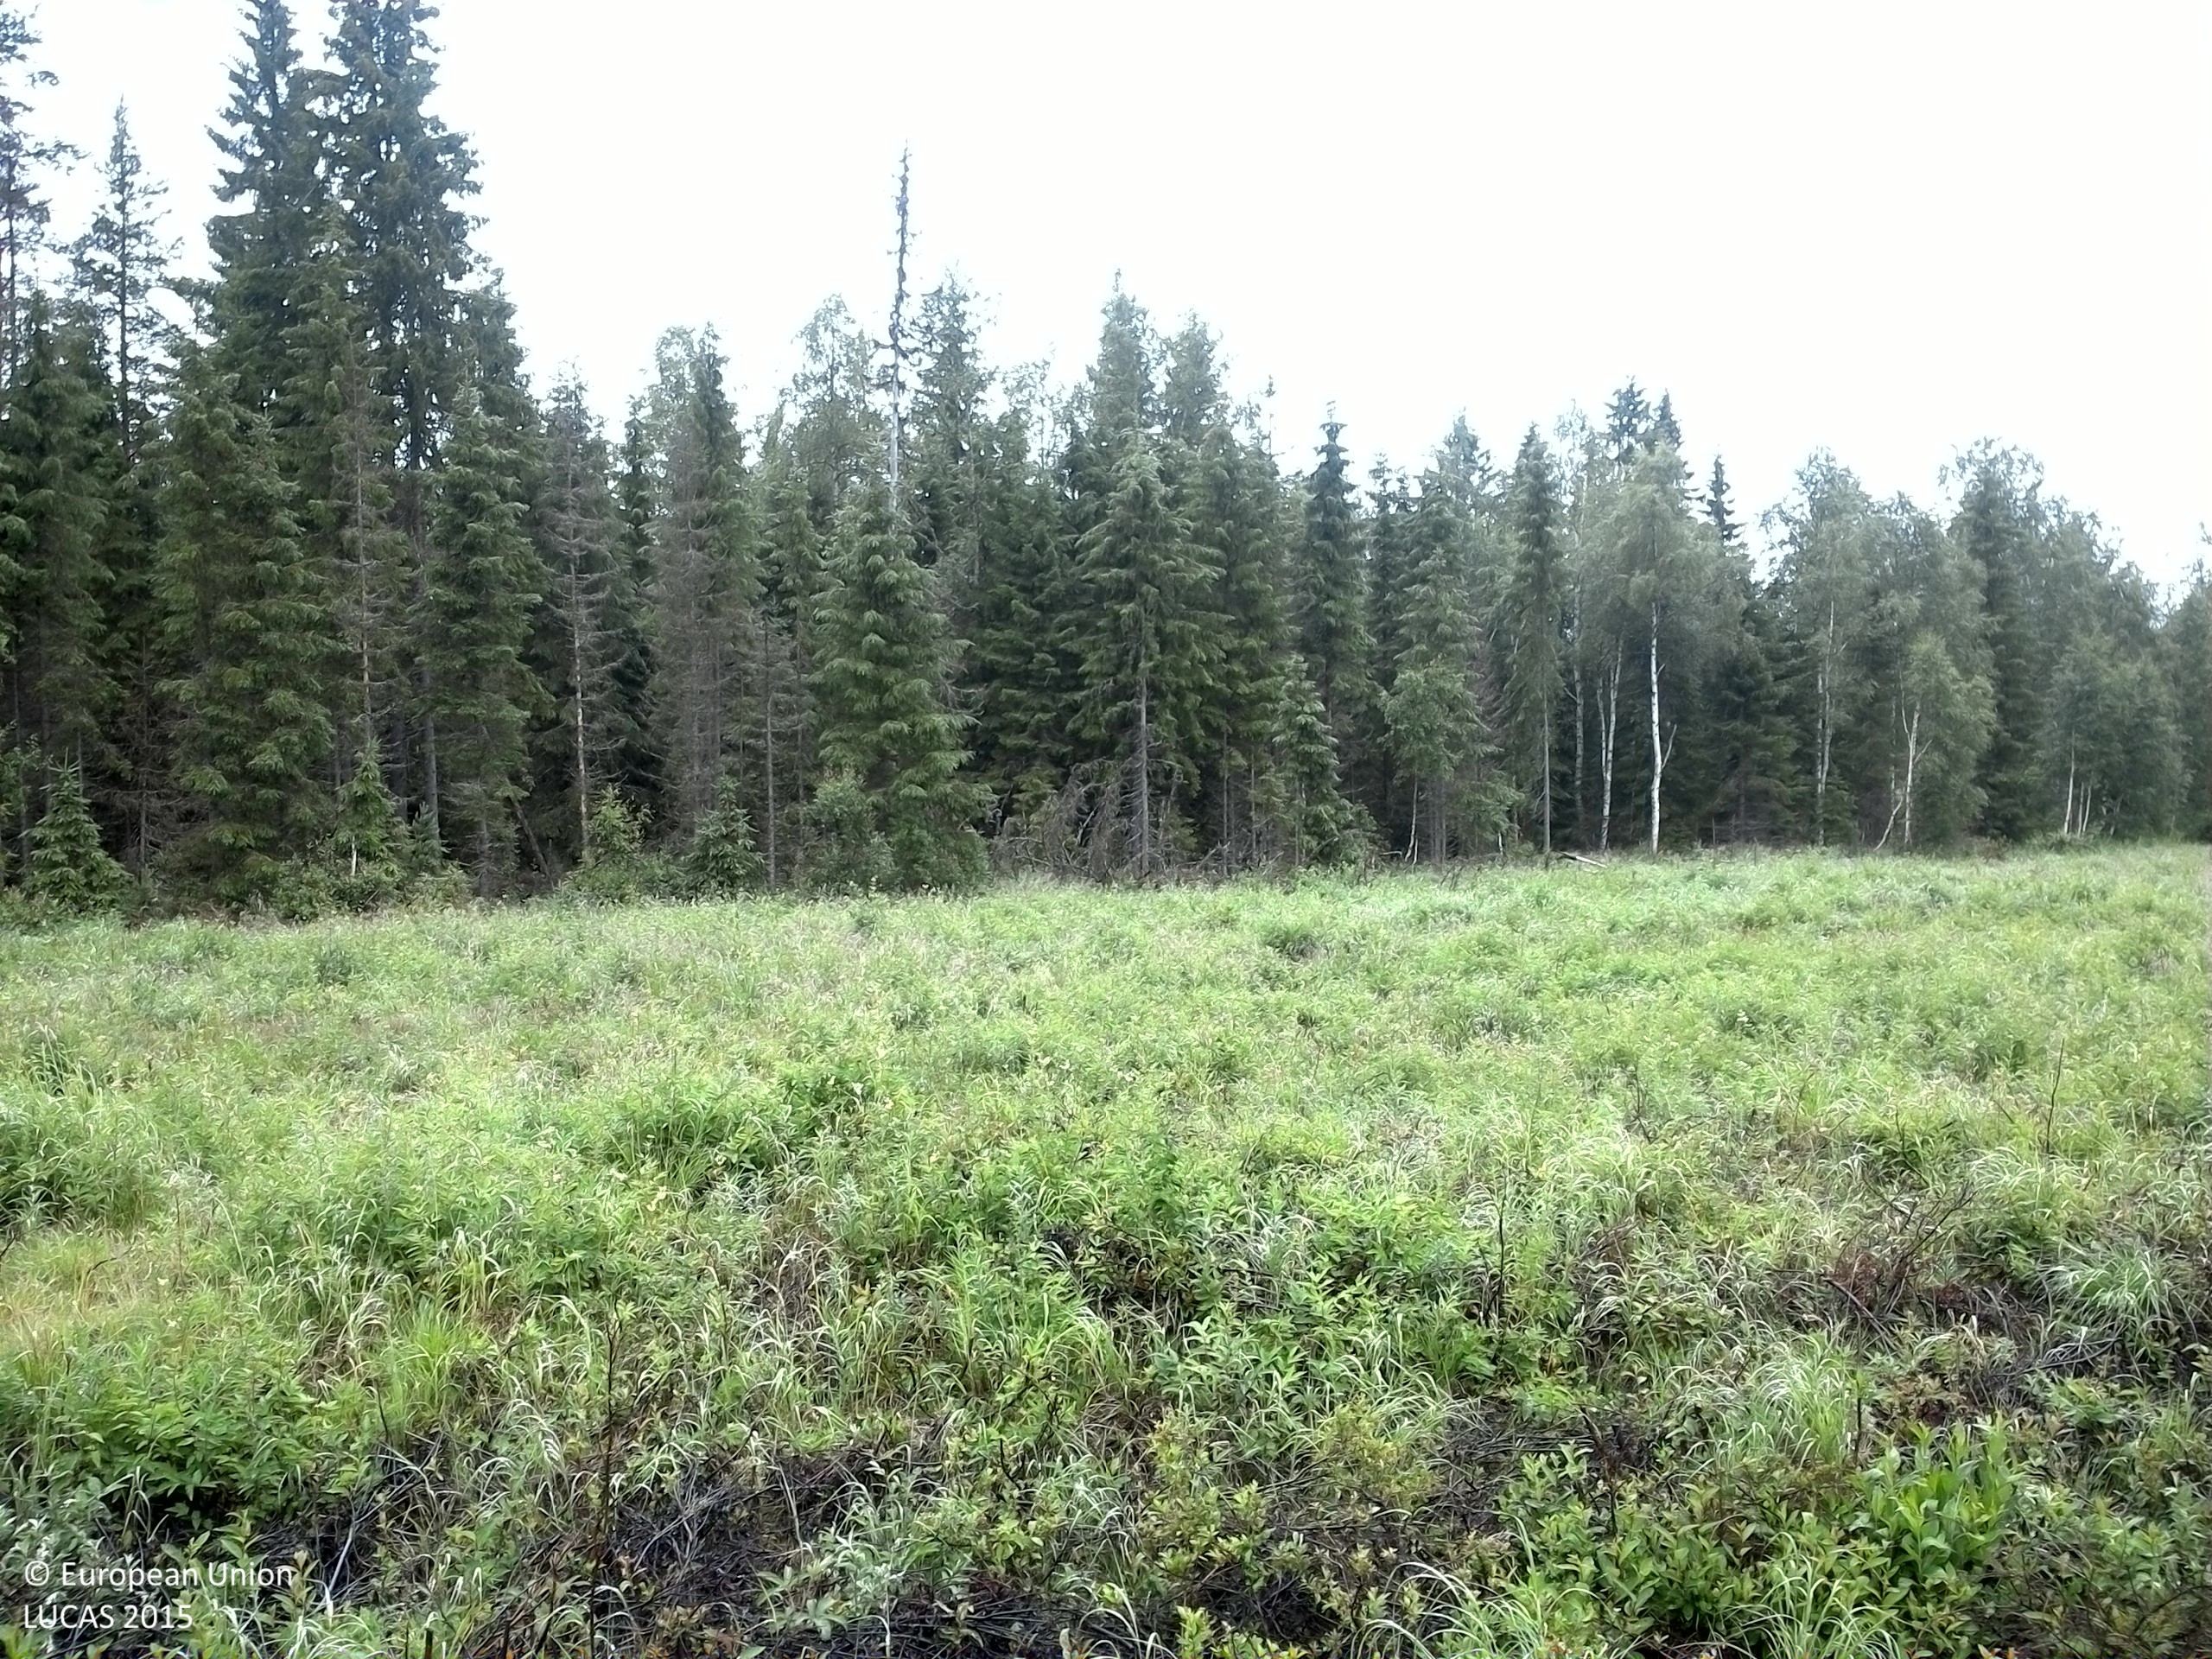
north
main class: Artificial land
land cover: Other artificial areas
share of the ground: 10 - 25 %
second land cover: Shrubland without tree cover
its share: > 75 %
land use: Electricity, gas and thermal power distribution
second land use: Amenities, museums, leisure
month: July
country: SE
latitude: 63.5485
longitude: 18.5679
